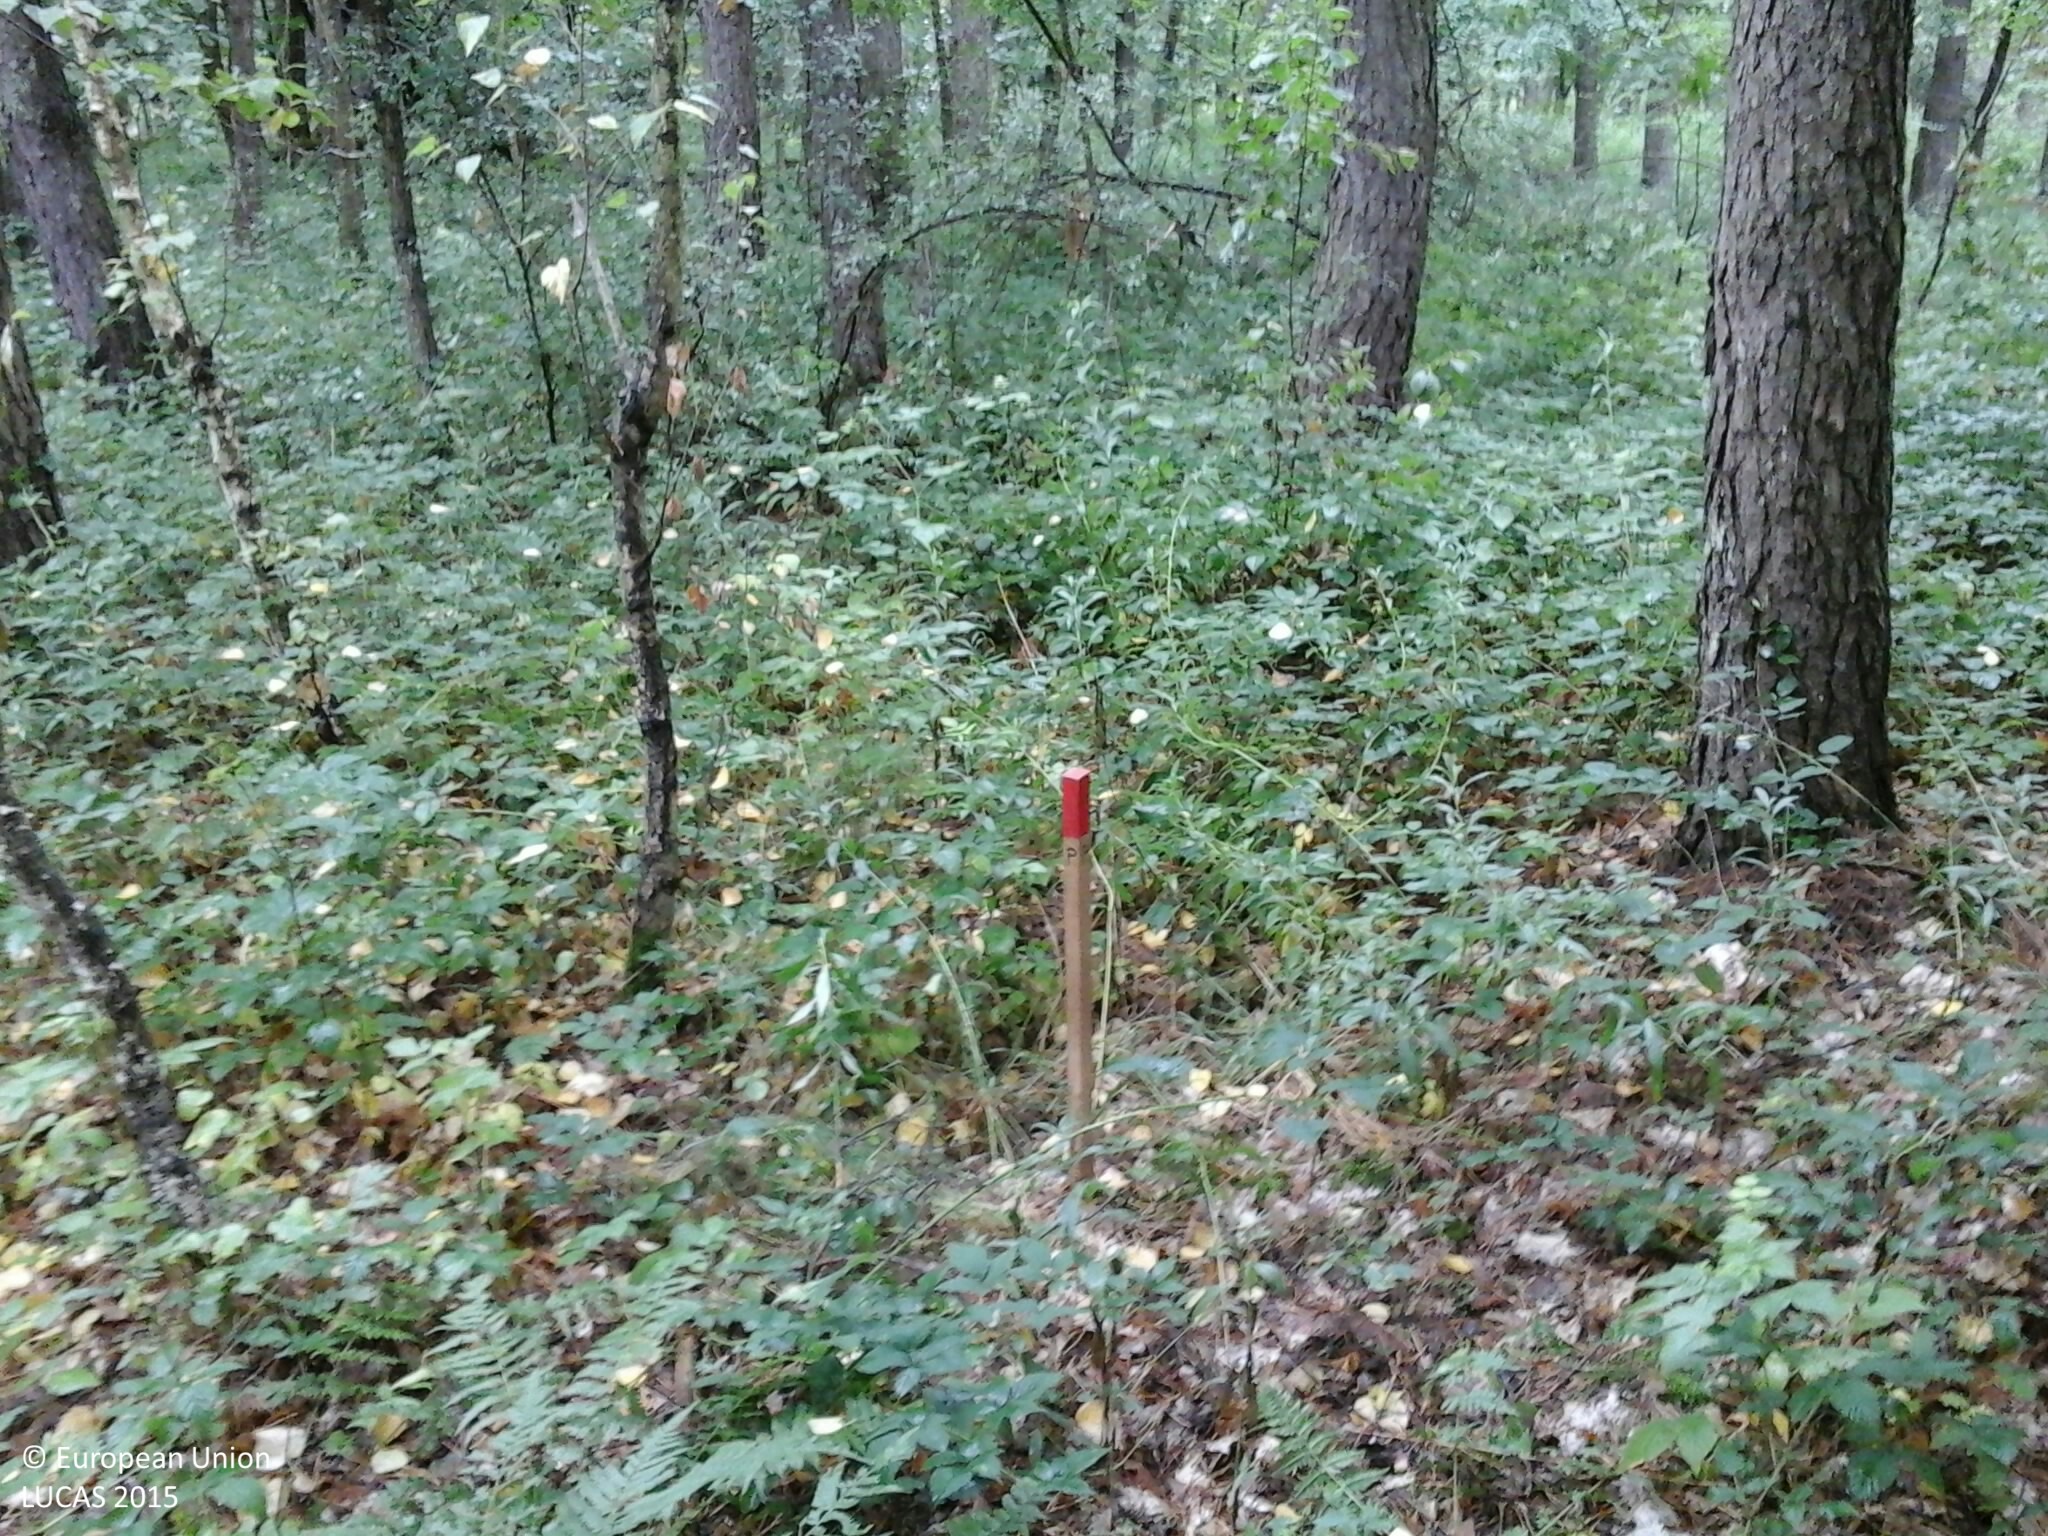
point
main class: Woodland
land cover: Pine dominated mixed woodland
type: hemiboreal forest and nemoral coniferous forest and mixed broadleaved-coniferous forest
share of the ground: > 75 %
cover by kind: coniferous forest trees 40 %, broadleaved forest trees 30 %, shrubs 20 %, herbaceous plants 10 %
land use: Forestry
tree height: > 5 m
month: July
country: HU
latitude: 46.9089
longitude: 16.5538
